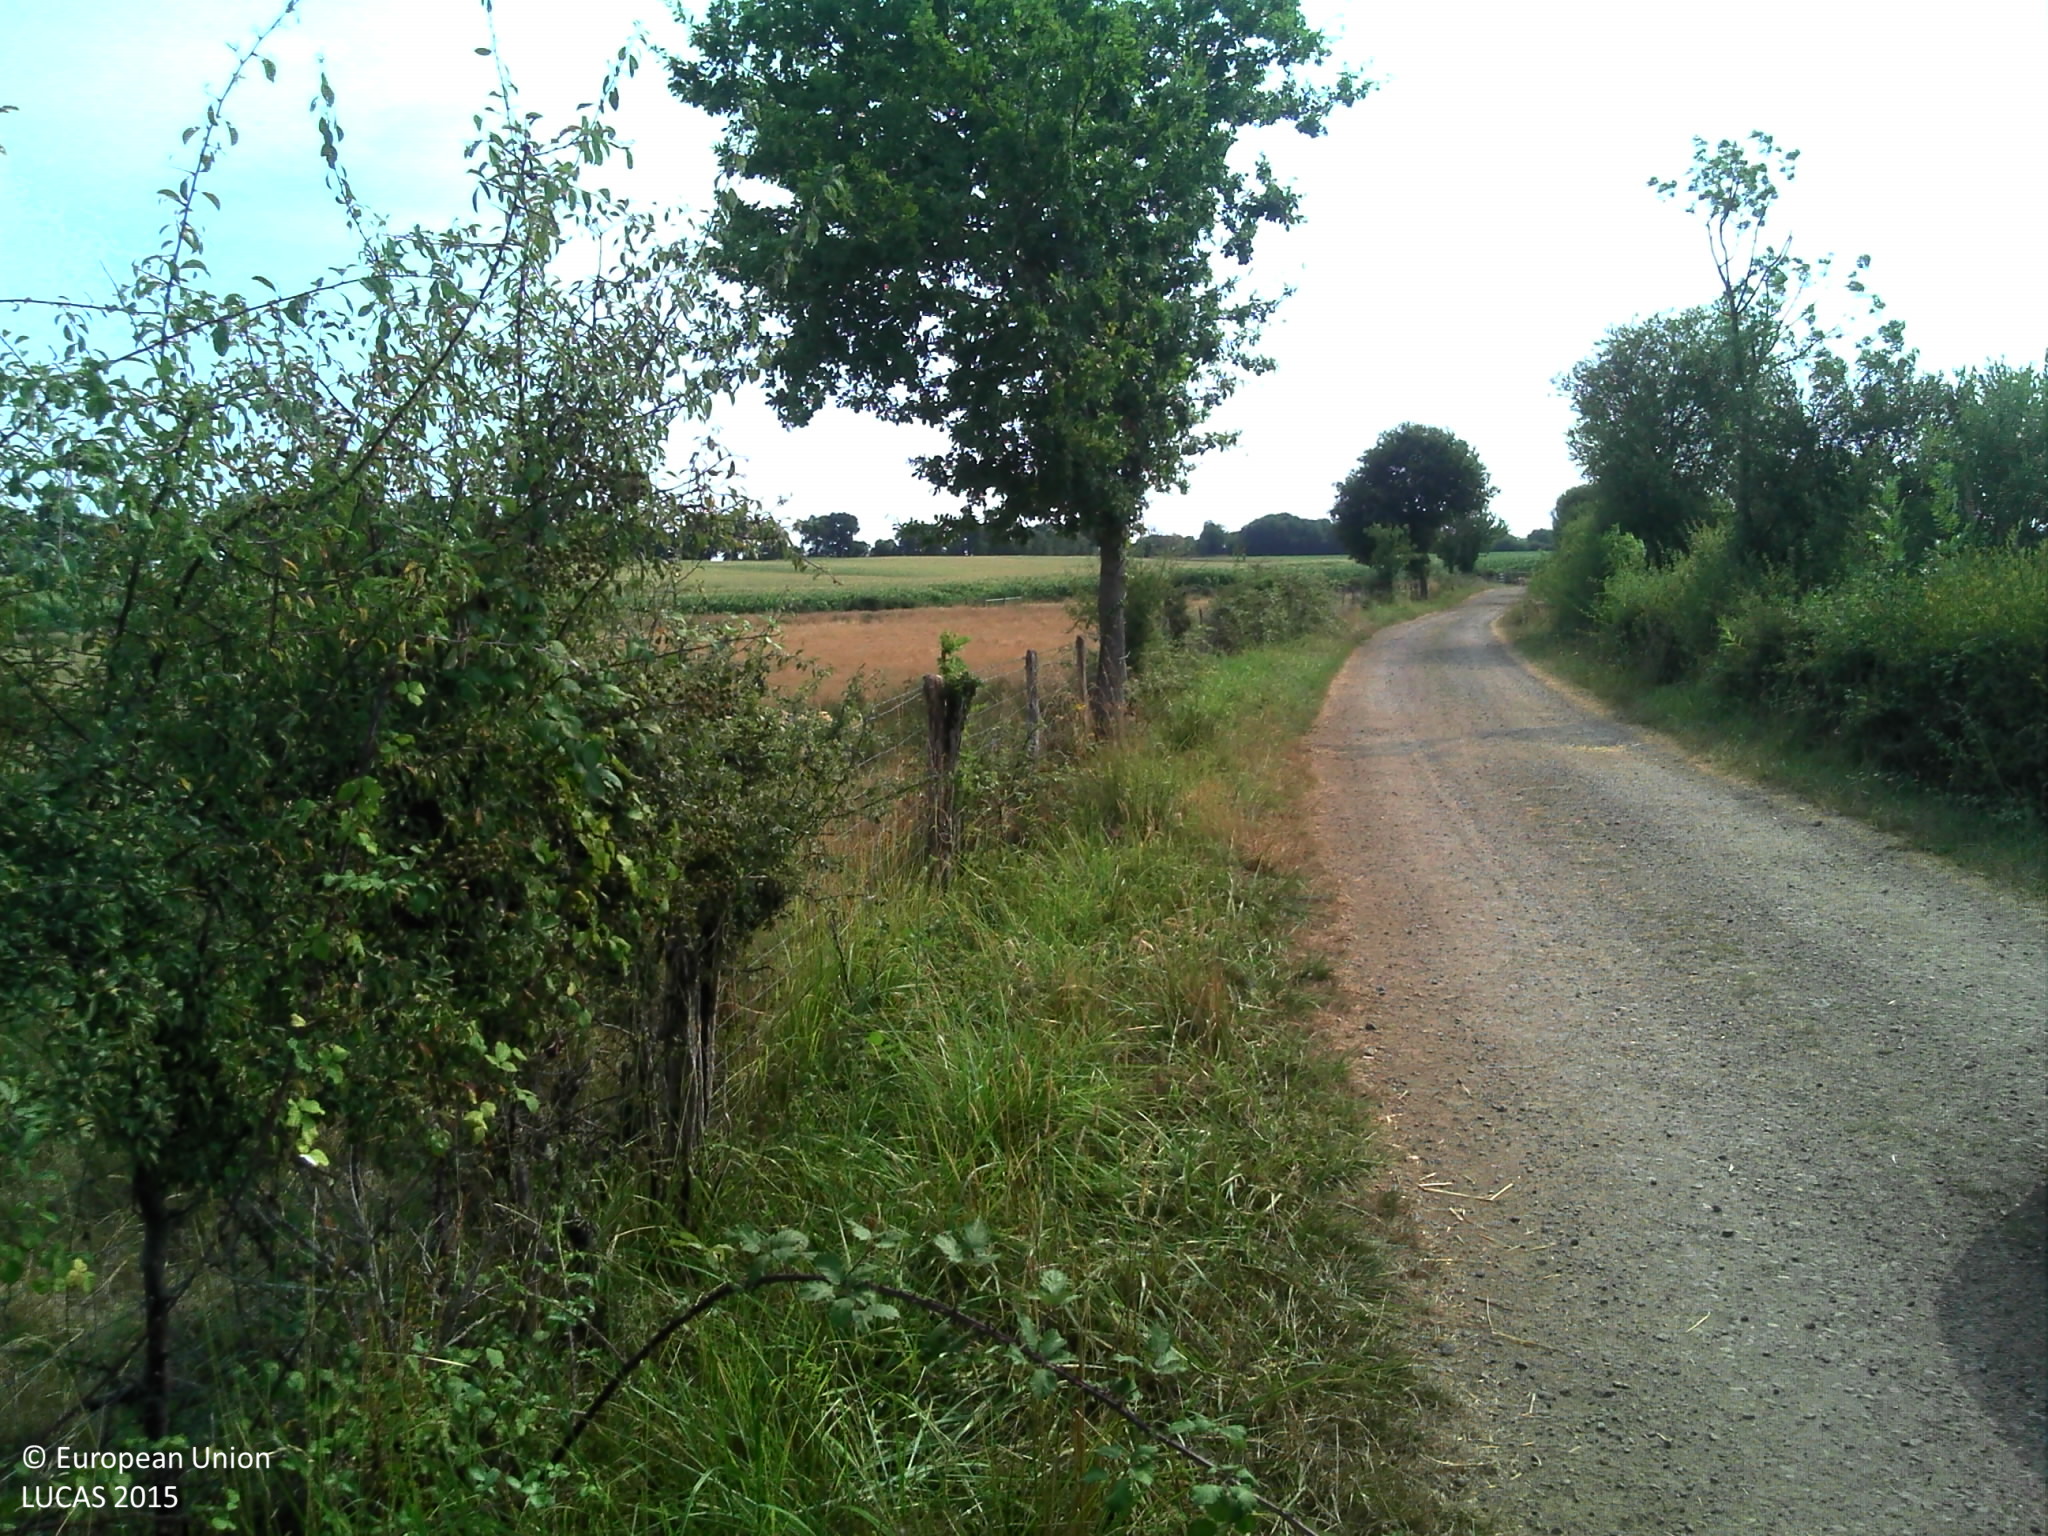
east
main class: Grassland
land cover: Grassland without tree/shrub cover
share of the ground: > 75 %
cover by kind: herbaceous plants 100 %
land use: Agriculture (excluding fallow land and kitchen gardens)
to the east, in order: Grassland without tree/shrub cover; Fences; Grassland without tree/shrub cover; Fences; Grassland without tree/shrub cover; Fences; Ditches and canals; Grassland without tree/shrub cover
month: July
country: FR
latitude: 46.1716
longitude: 0.5941
